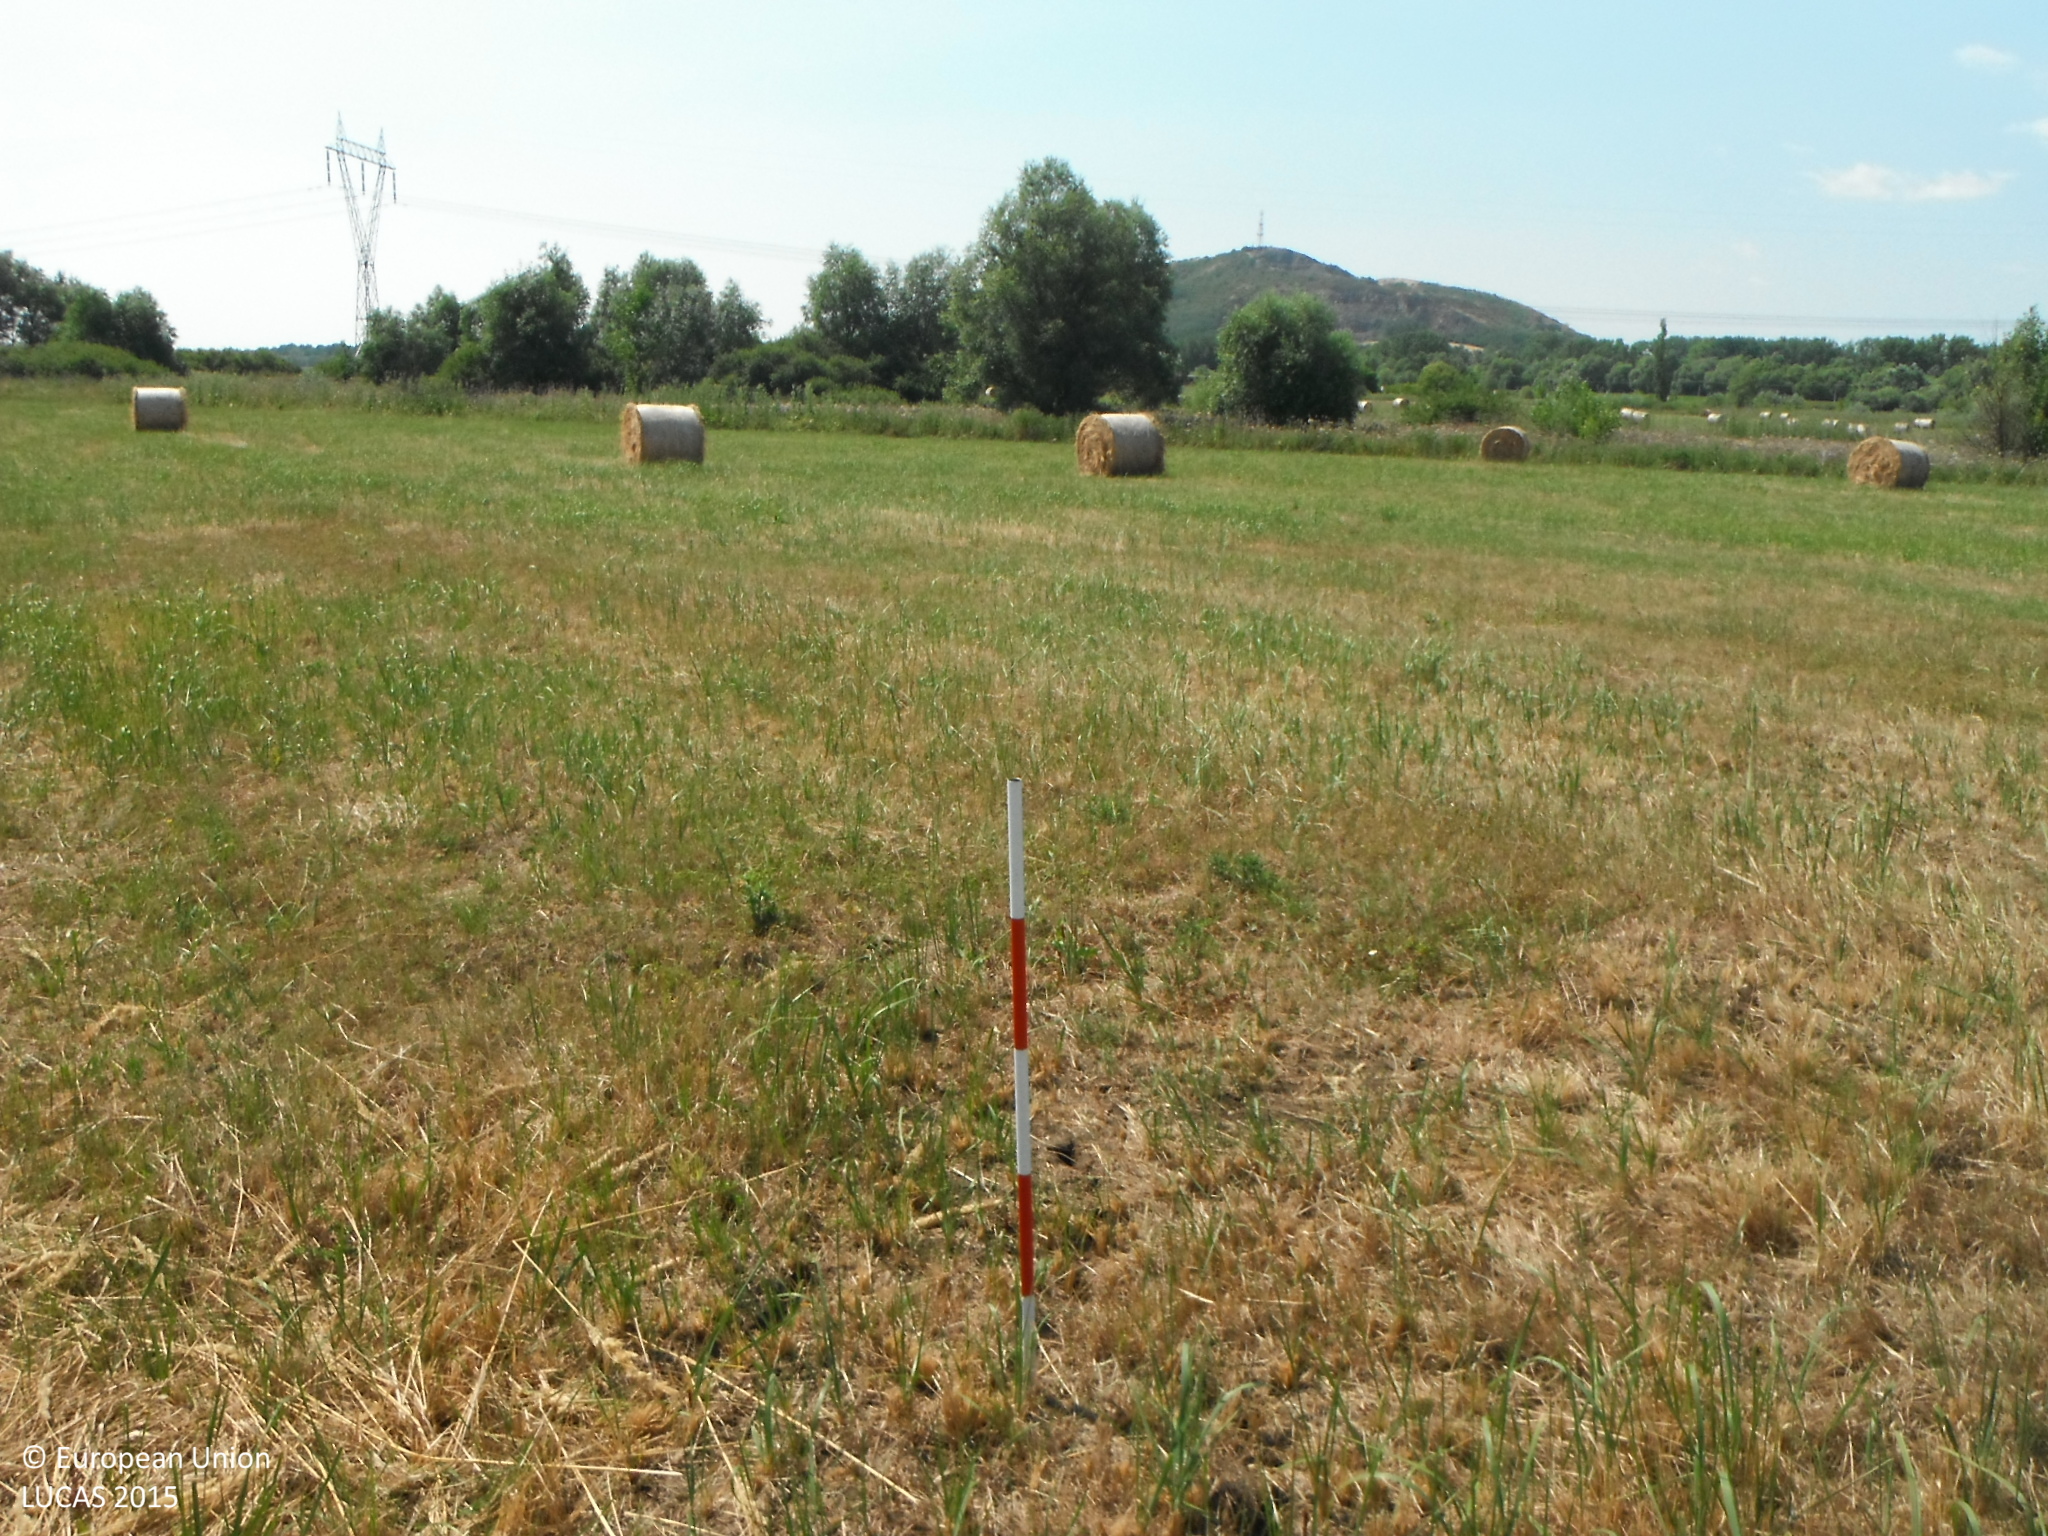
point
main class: Grassland
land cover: Grassland without tree/shrub cover
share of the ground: > 75 %
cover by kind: herbaceous plants 100 %
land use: Agriculture (excluding fallow land and kitchen gardens)
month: July
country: SK
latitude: 48.5130
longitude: 21.8152
